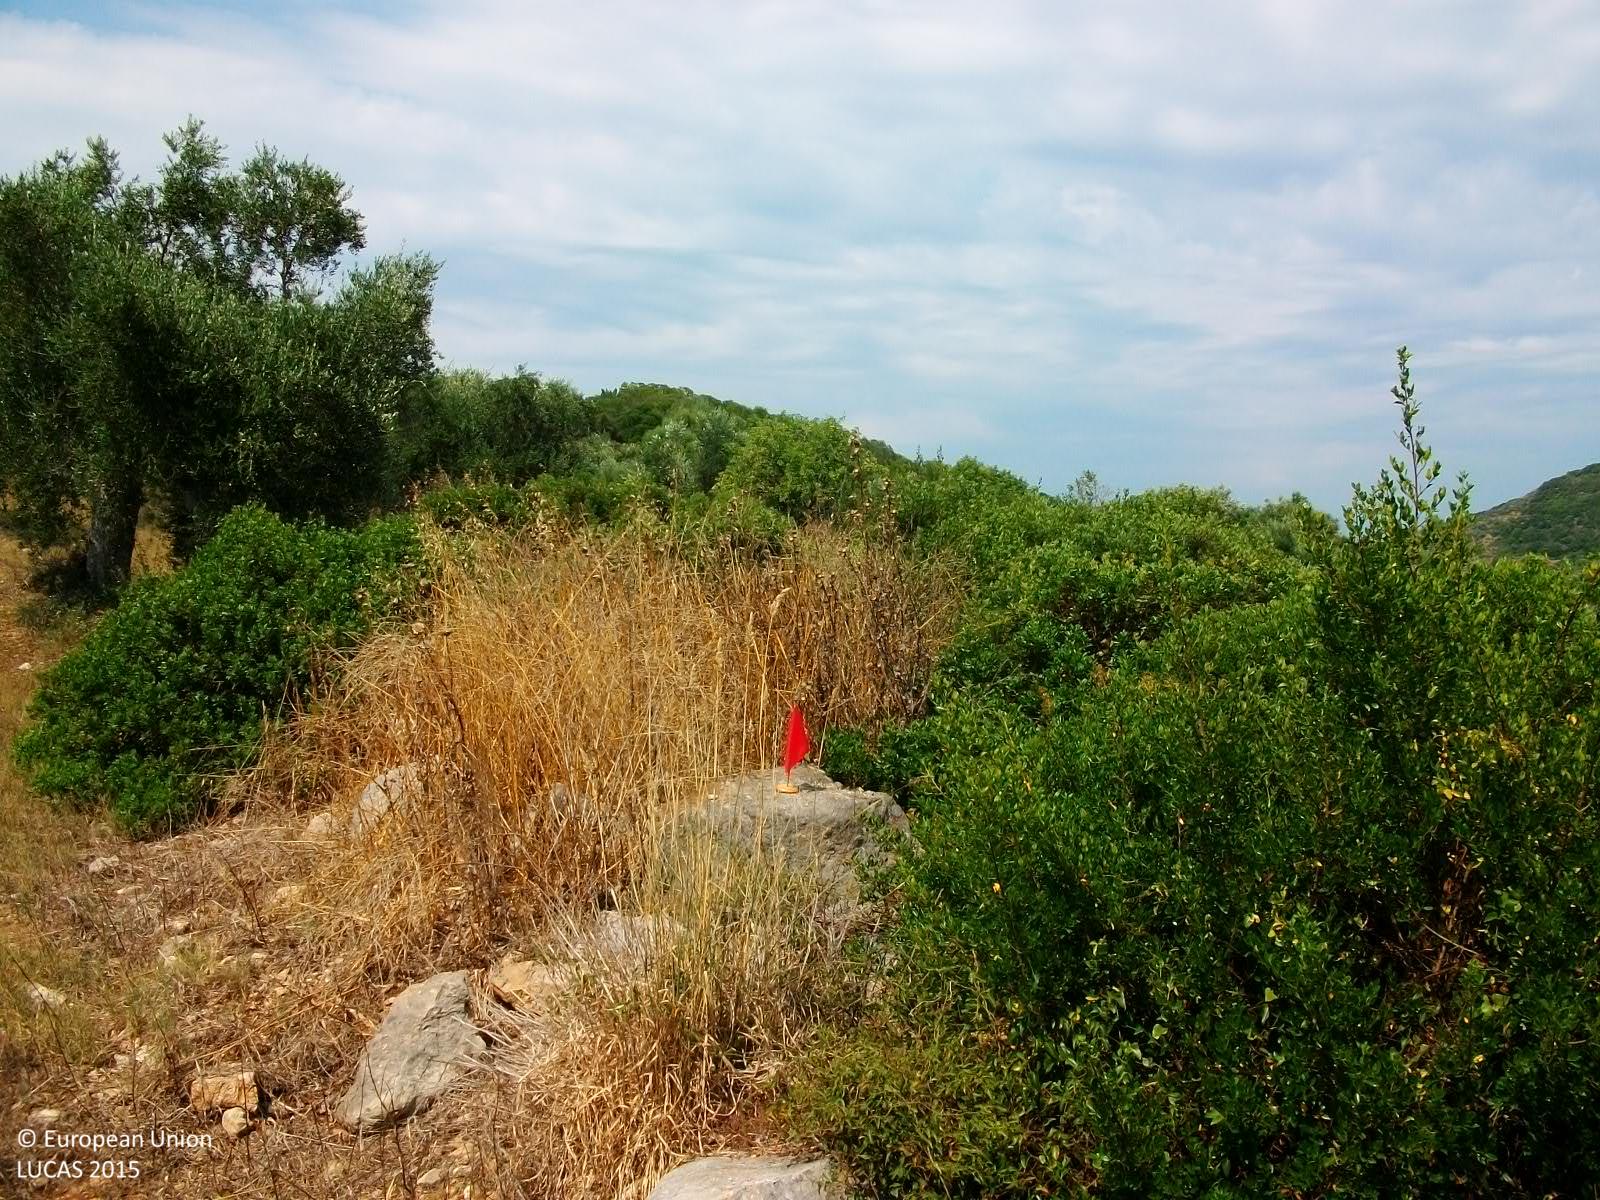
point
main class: Cropland
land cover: Olive groves
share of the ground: > 75 %
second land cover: Spontaneously vegetated surfaces
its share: > 75 %
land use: Agriculture (excluding fallow land and kitchen gardens)
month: July
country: GR
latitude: 36.8393
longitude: 21.8469
